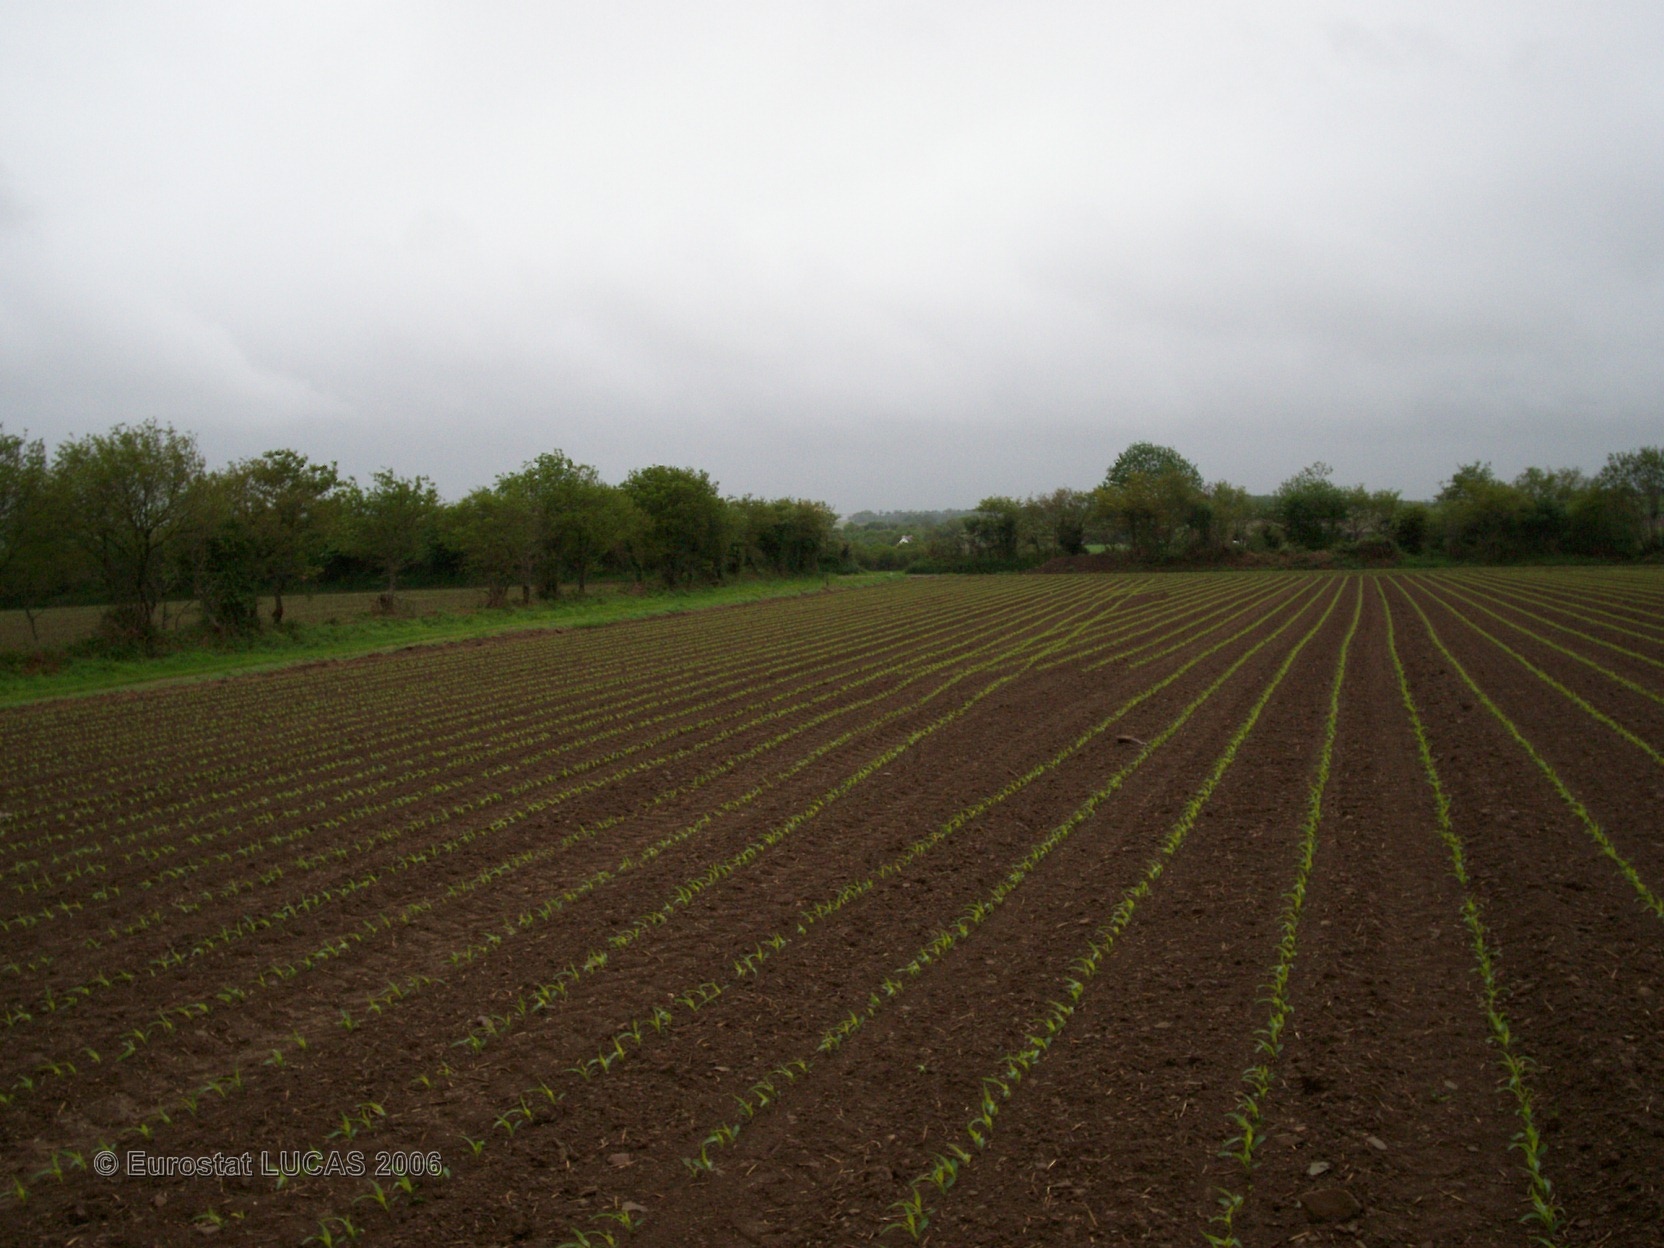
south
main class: Cropland
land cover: Maize
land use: Agriculture (excluding fallow land and kitchen gardens)
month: May
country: FR
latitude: 48.2994
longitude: -3.6560
